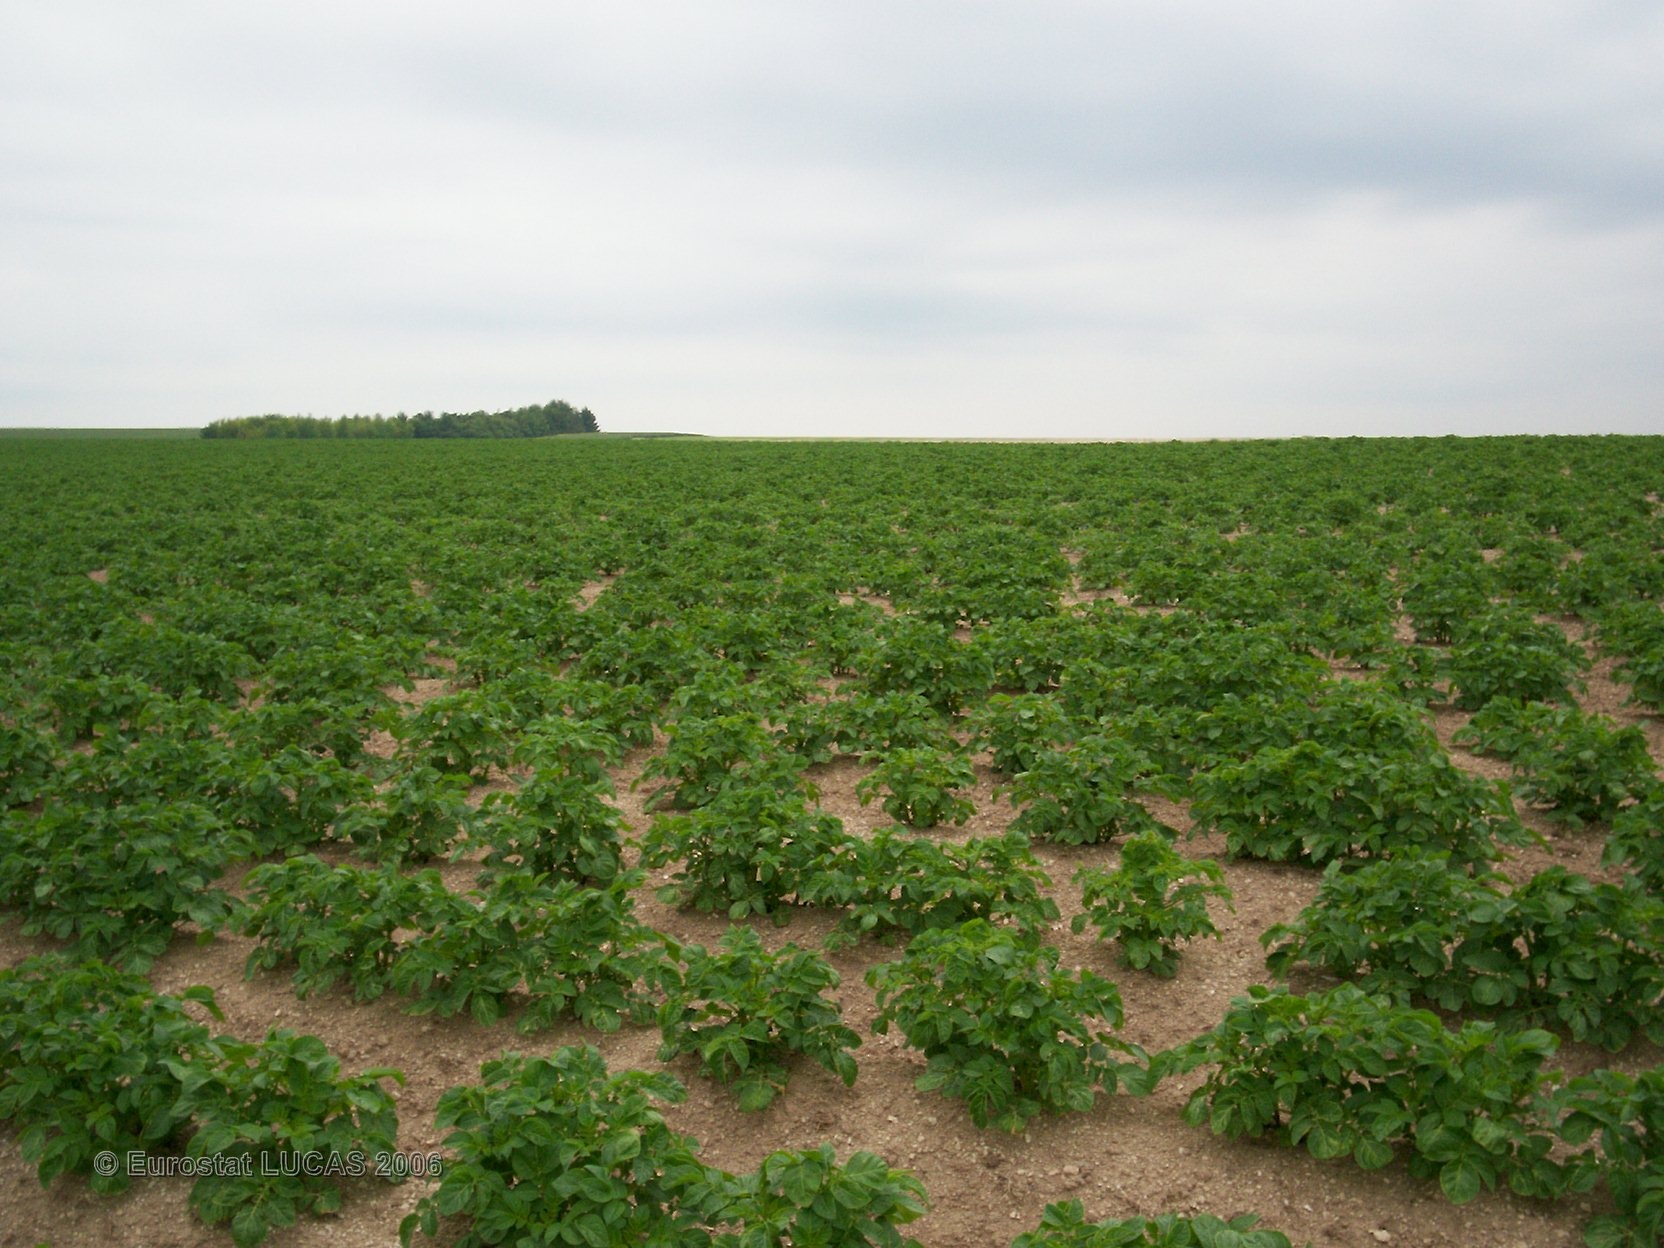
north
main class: Cropland
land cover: Potatoes
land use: Agriculture (excluding fallow land and kitchen gardens)
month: June
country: FR
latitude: 48.7502
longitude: 4.4340
